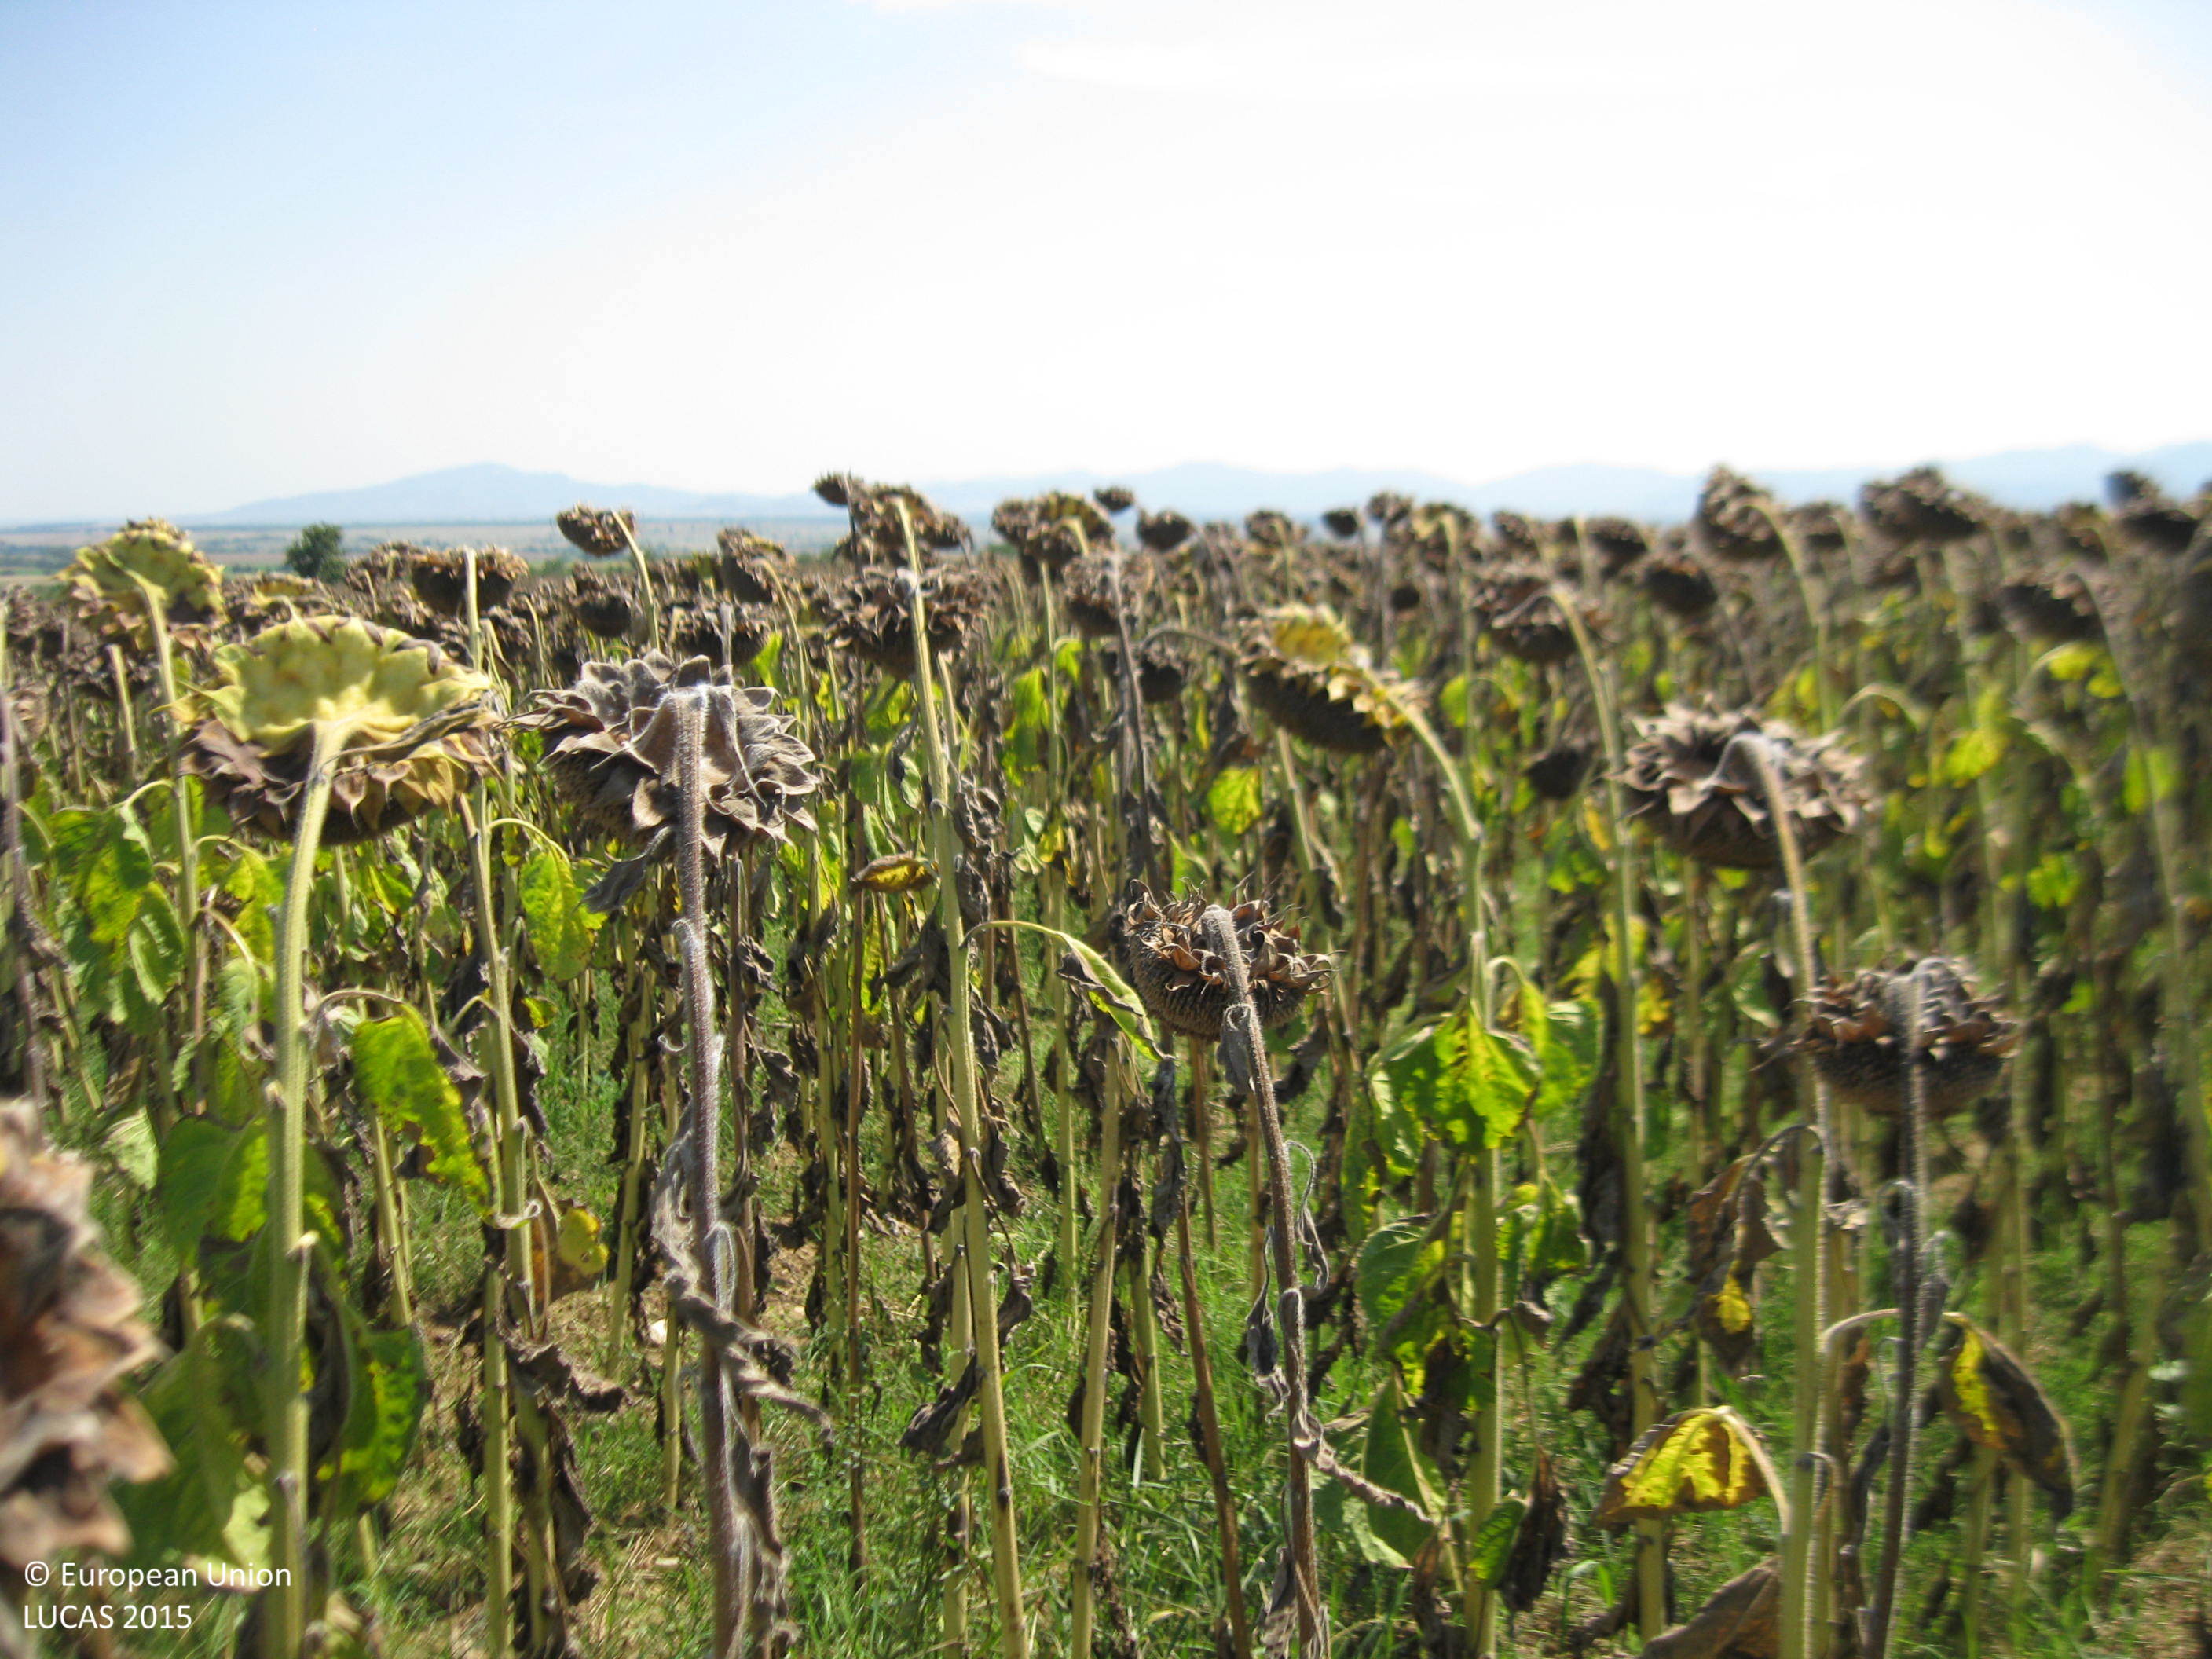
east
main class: Cropland
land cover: Sunflower
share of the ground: > 75 %
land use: Agriculture (excluding fallow land and kitchen gardens)
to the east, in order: Sunflower
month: August
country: BG
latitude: 41.9585
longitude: 24.9532
